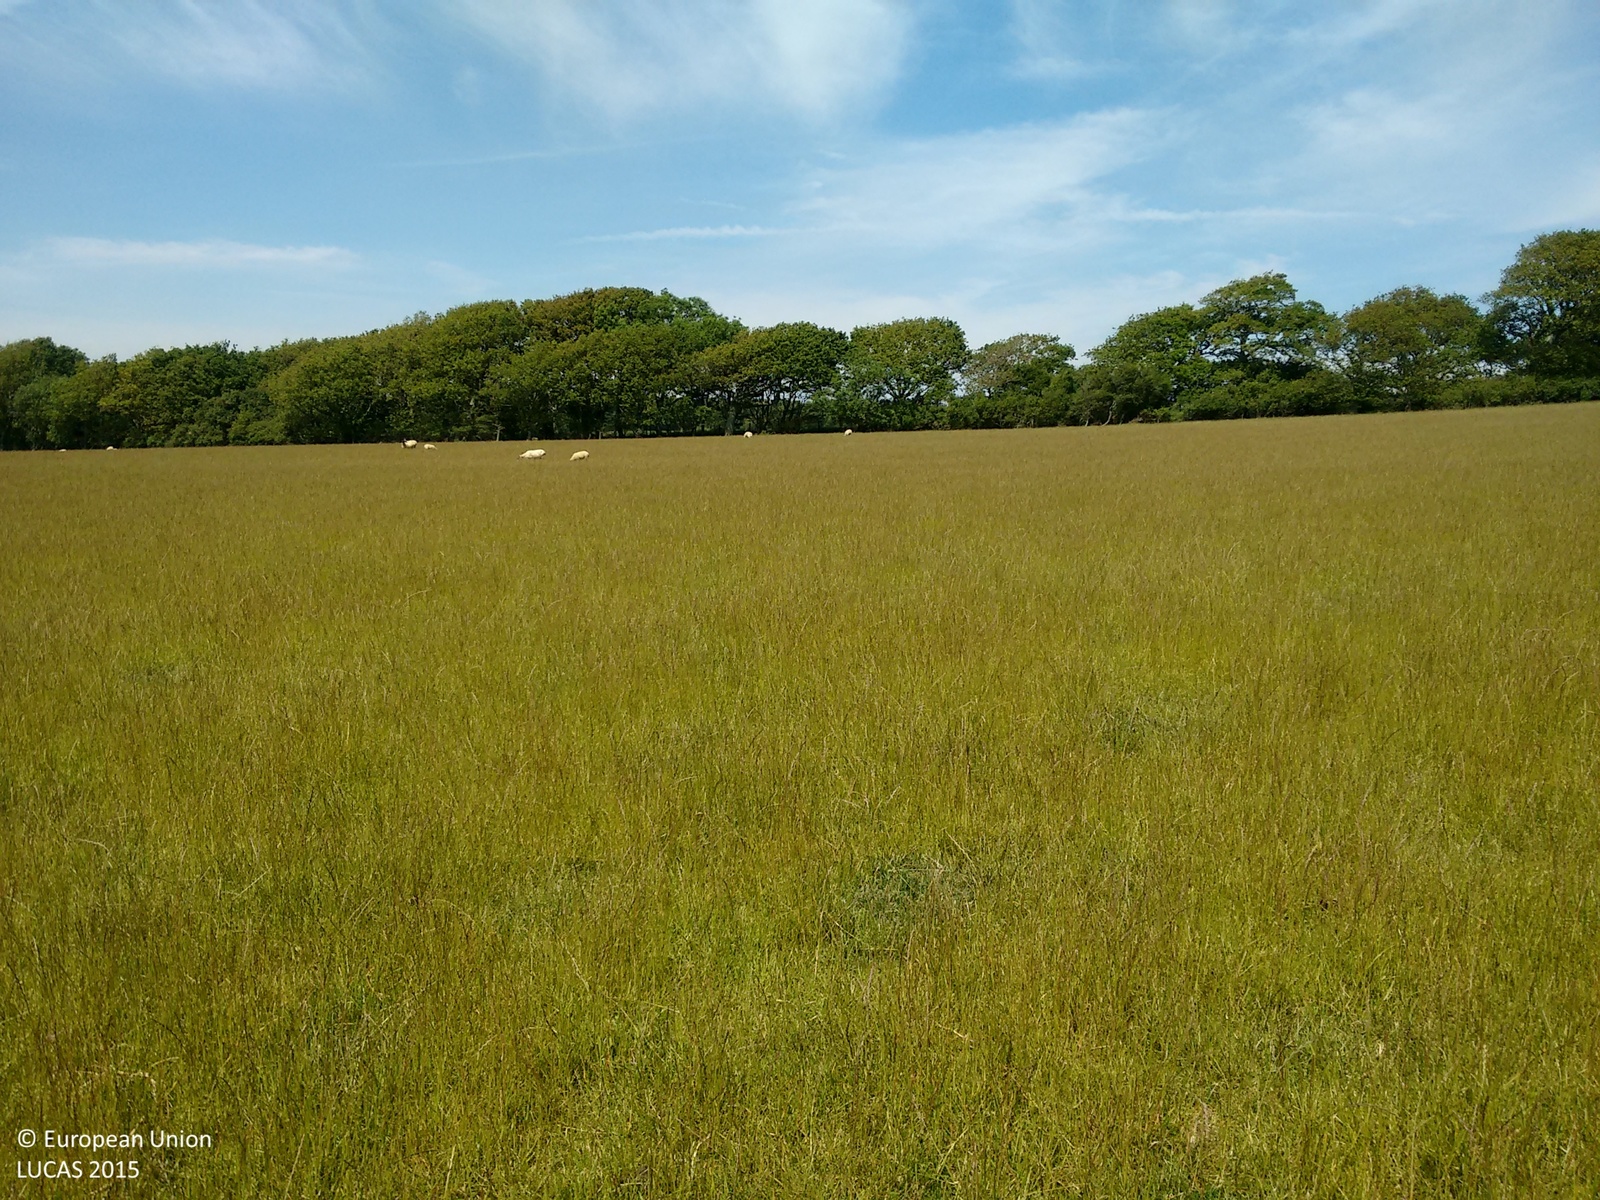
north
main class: Grassland
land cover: Grassland without tree/shrub cover
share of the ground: > 75 %
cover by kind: herbaceous plants 100 %
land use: Agriculture (excluding fallow land and kitchen gardens)
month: June
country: GB
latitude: 50.8312
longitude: 0.2154
